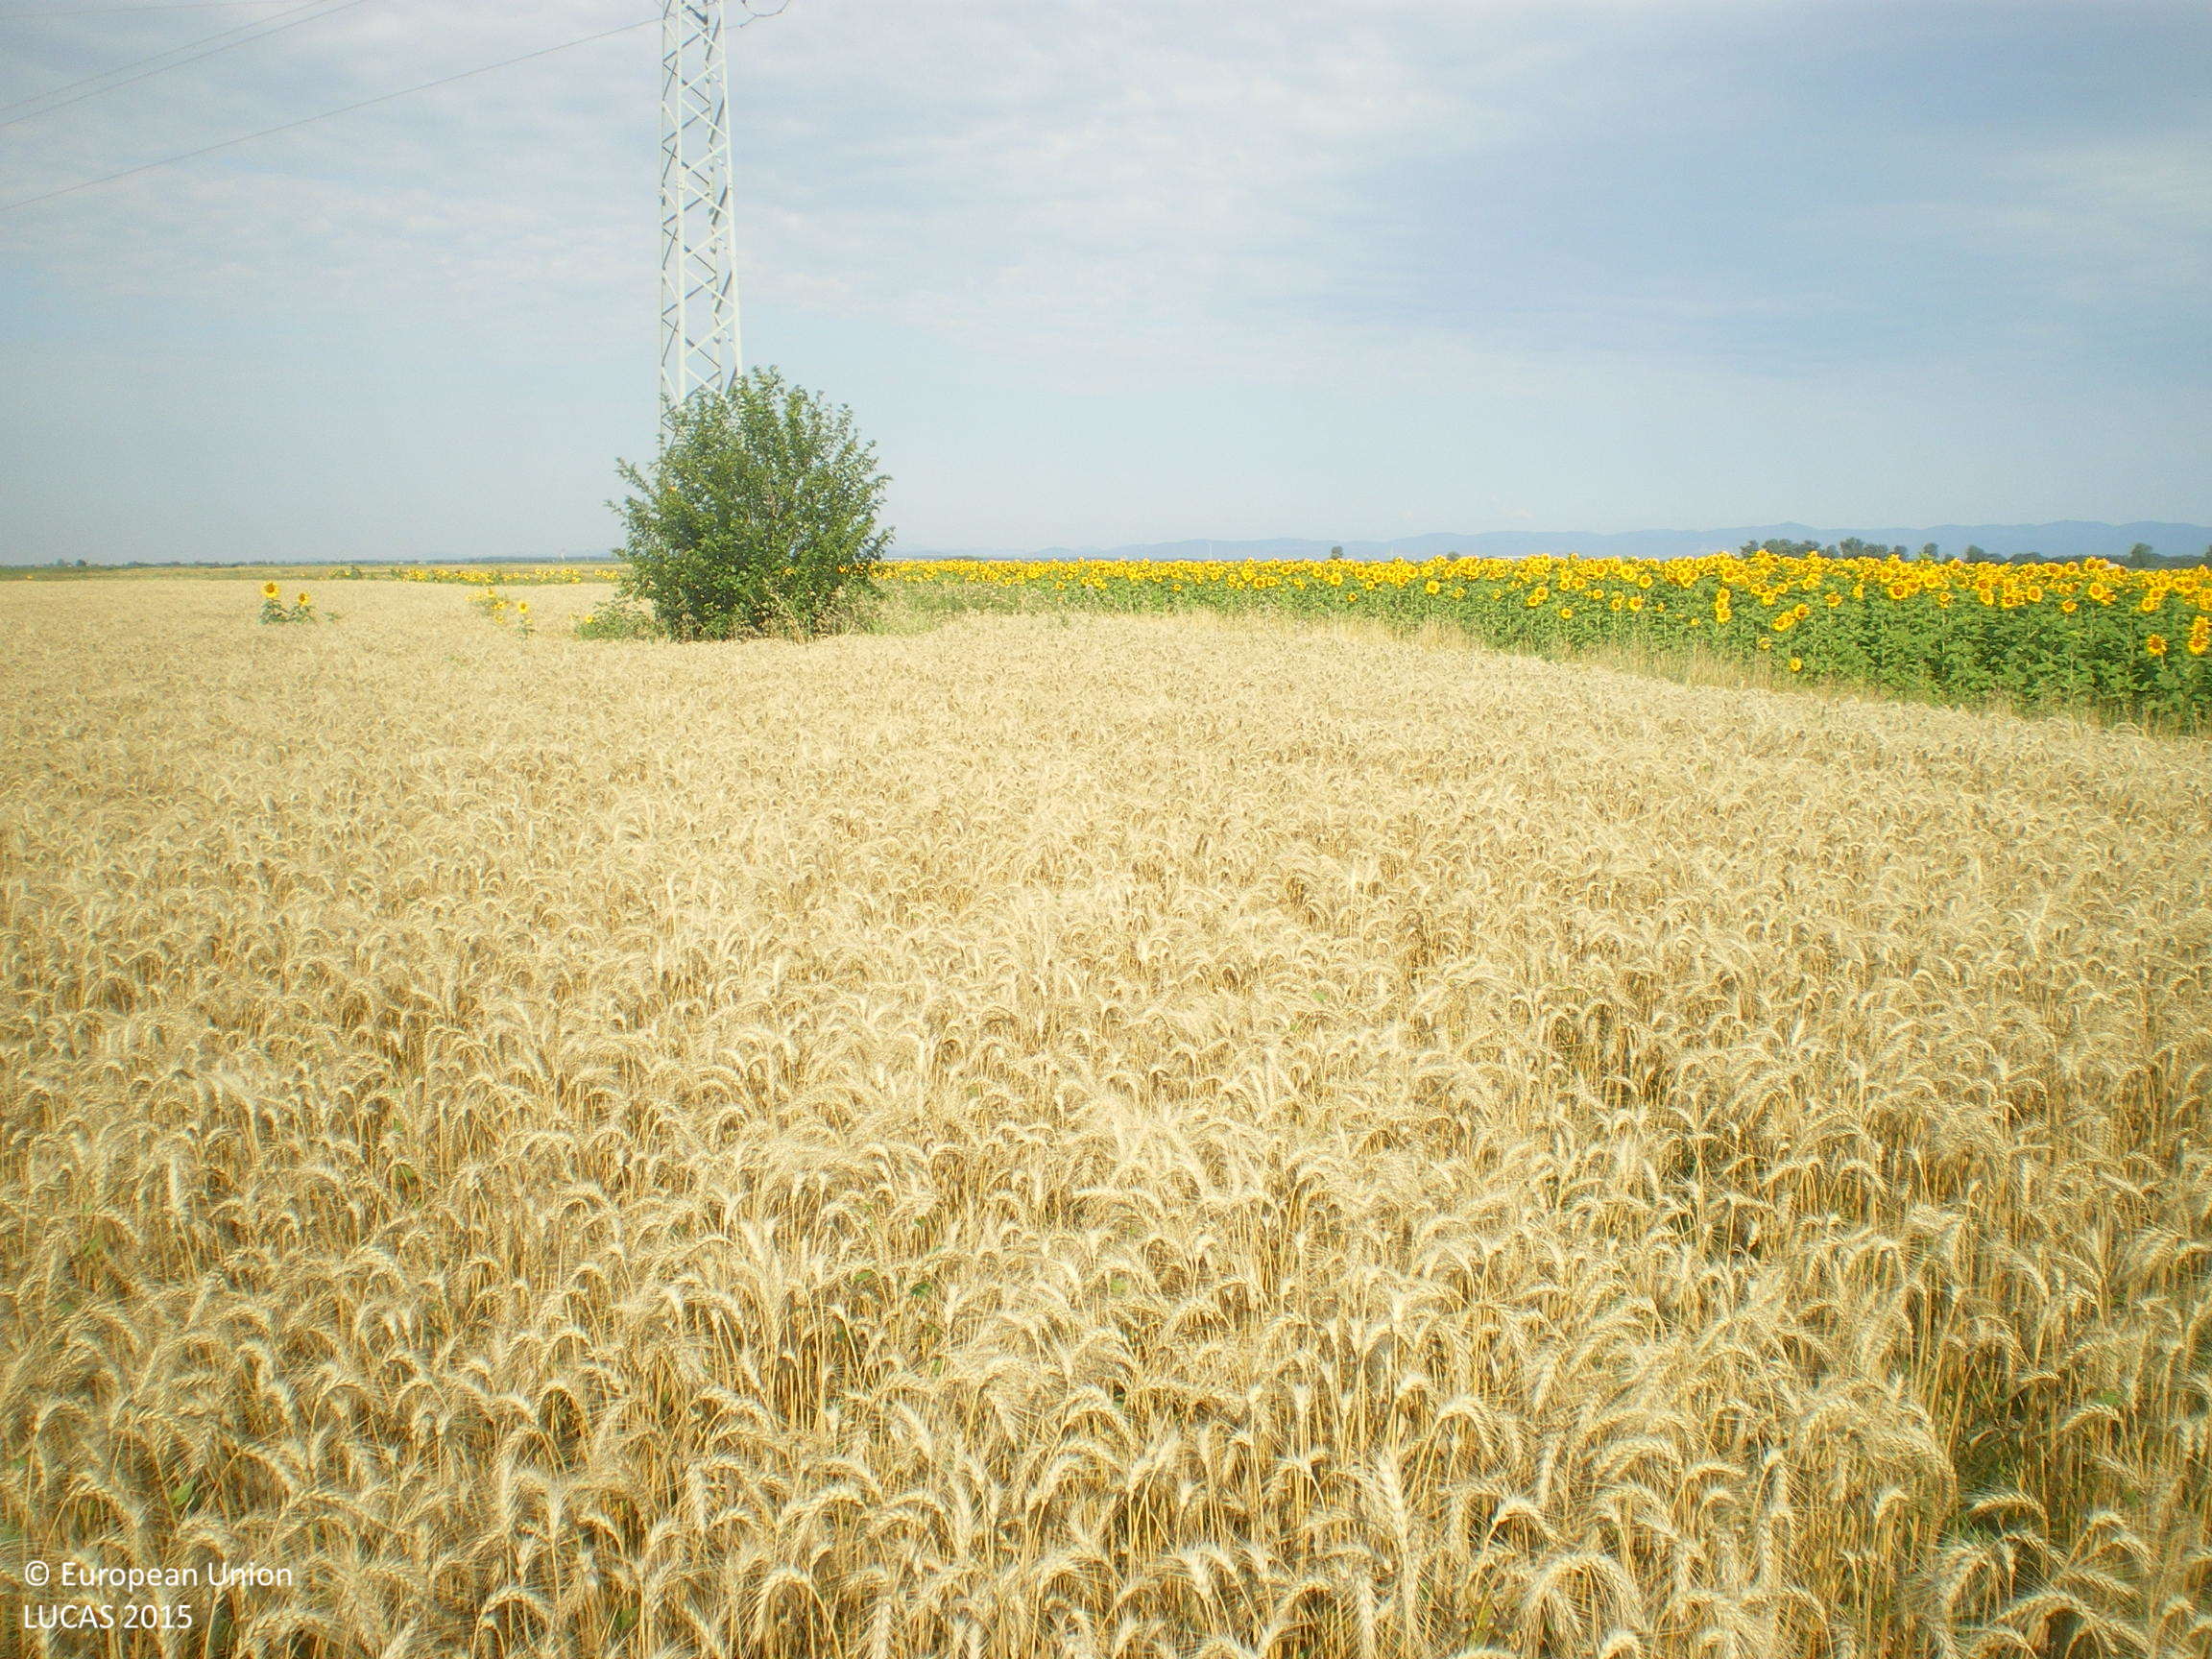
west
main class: Cropland
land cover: Barley
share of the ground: > 75 %
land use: Agriculture (excluding fallow land and kitchen gardens)
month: July
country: BG
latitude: 42.3702
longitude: 25.8502
